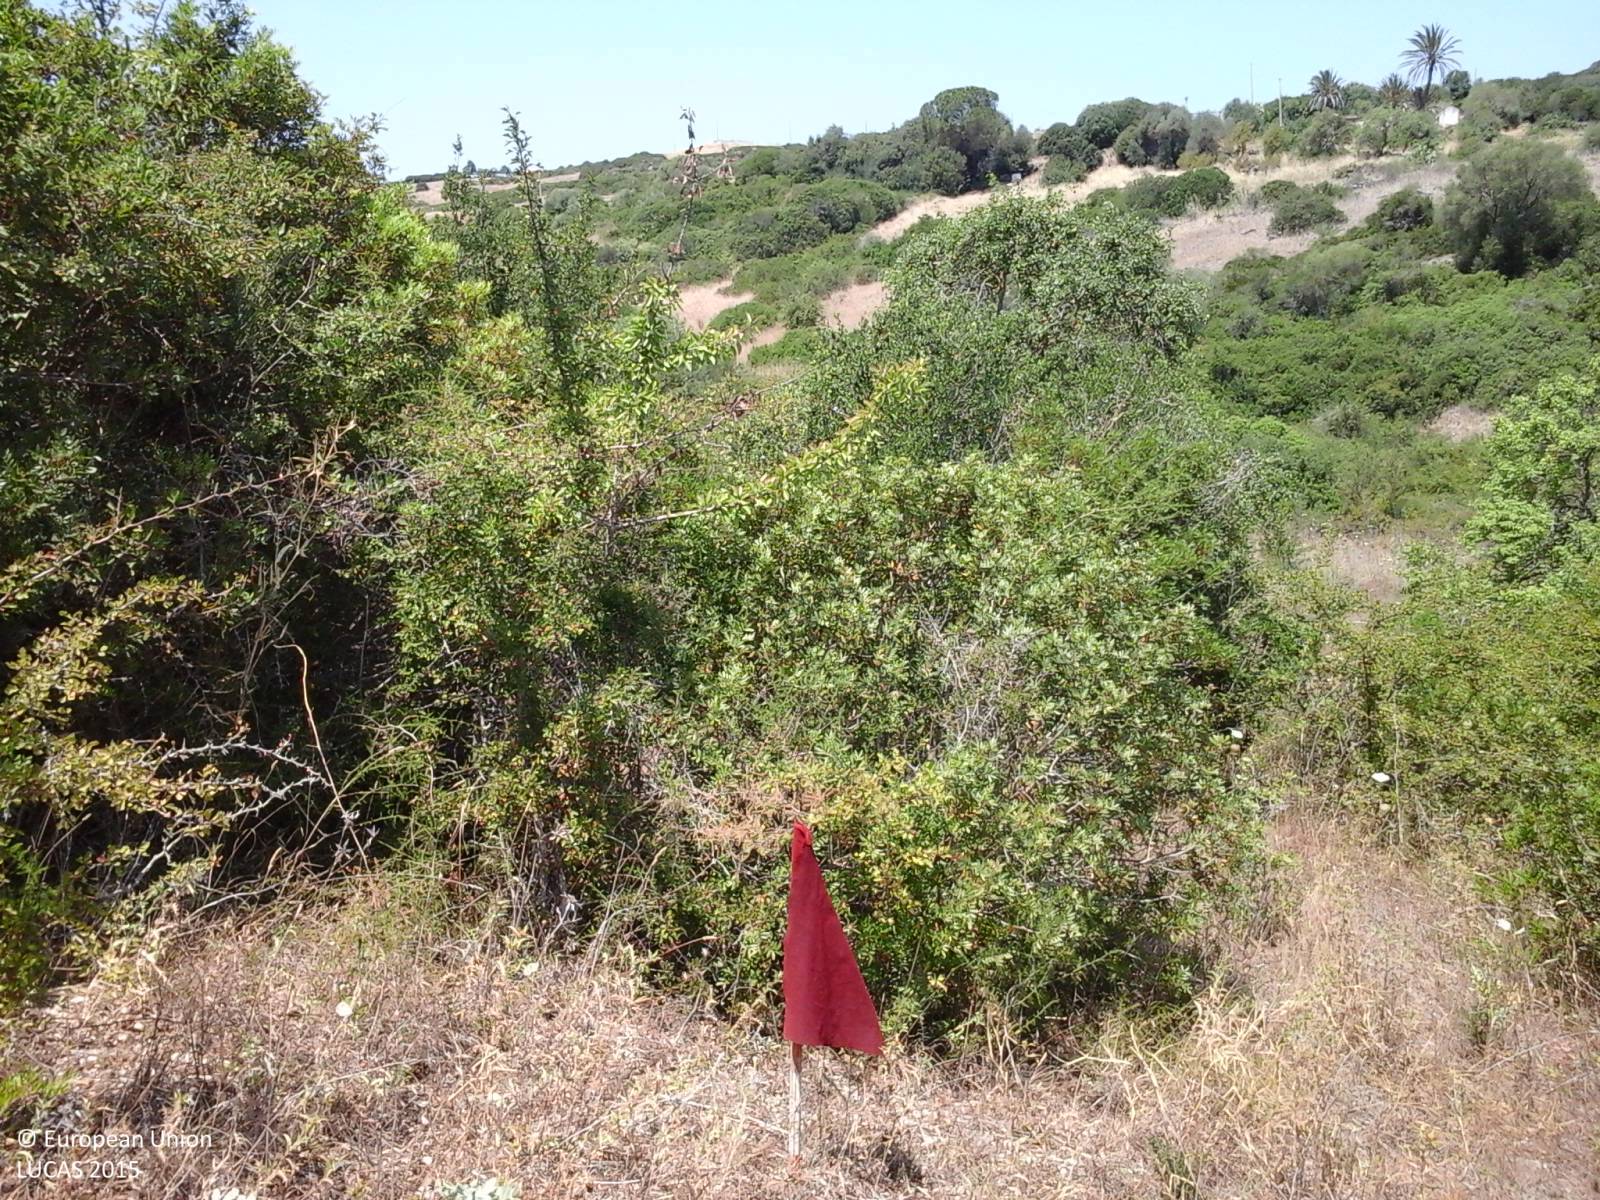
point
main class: Shrubland
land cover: Shrubland with sparse tree cover
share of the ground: > 75 %
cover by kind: herbaceous plants 55 %, shrubs 40 %, broadleaved forest trees 5 %
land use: Semi-natural and natural areas not in use
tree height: < 5 m
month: July
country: IT
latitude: 40.8401
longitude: 8.8786
